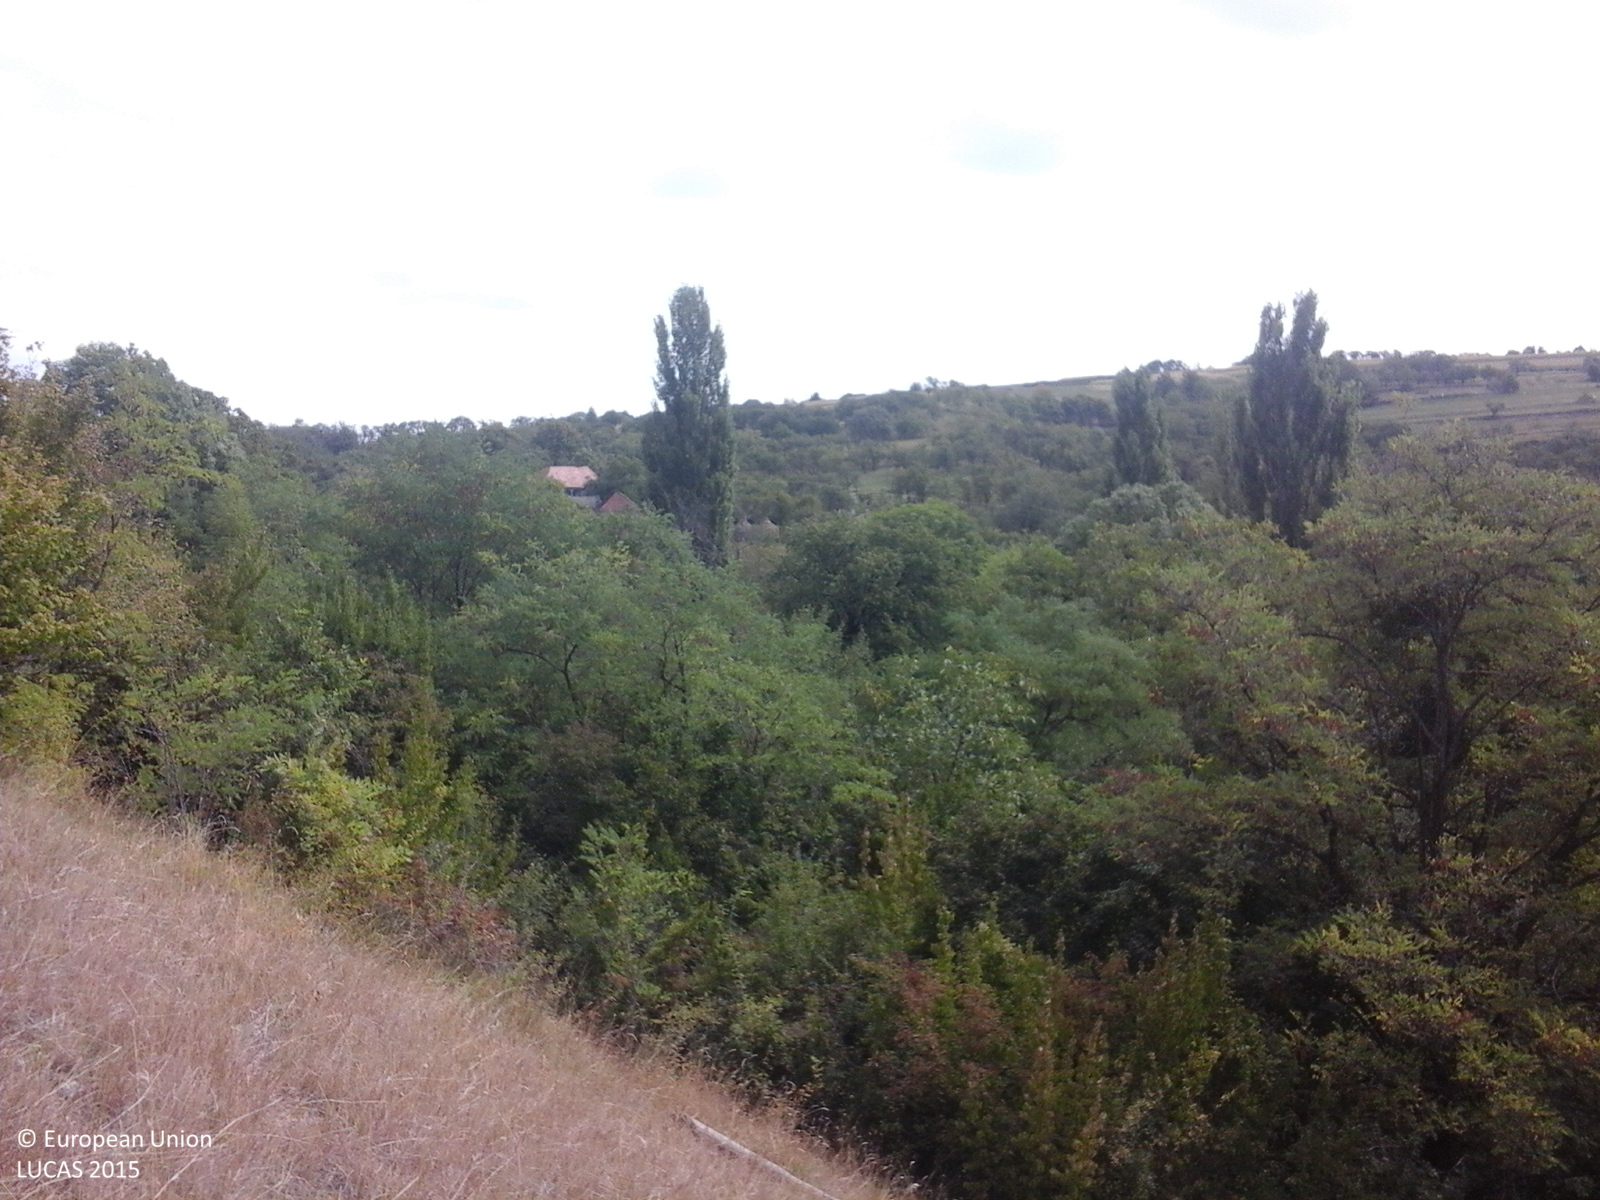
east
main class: Grassland
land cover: Grassland with sparse tree/shrub cover
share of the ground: > 75 %
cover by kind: herbaceous plants 85 %, shrubs 10 %, broadleaved forest trees 5 %
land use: Agriculture (excluding fallow land and kitchen gardens)
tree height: < 5 m
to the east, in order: Grassland with sparse tree/shrub cover; Broadleaved woodland; Other fruit trees and berries
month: September
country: RO
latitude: 47.4600
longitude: 23.5114
